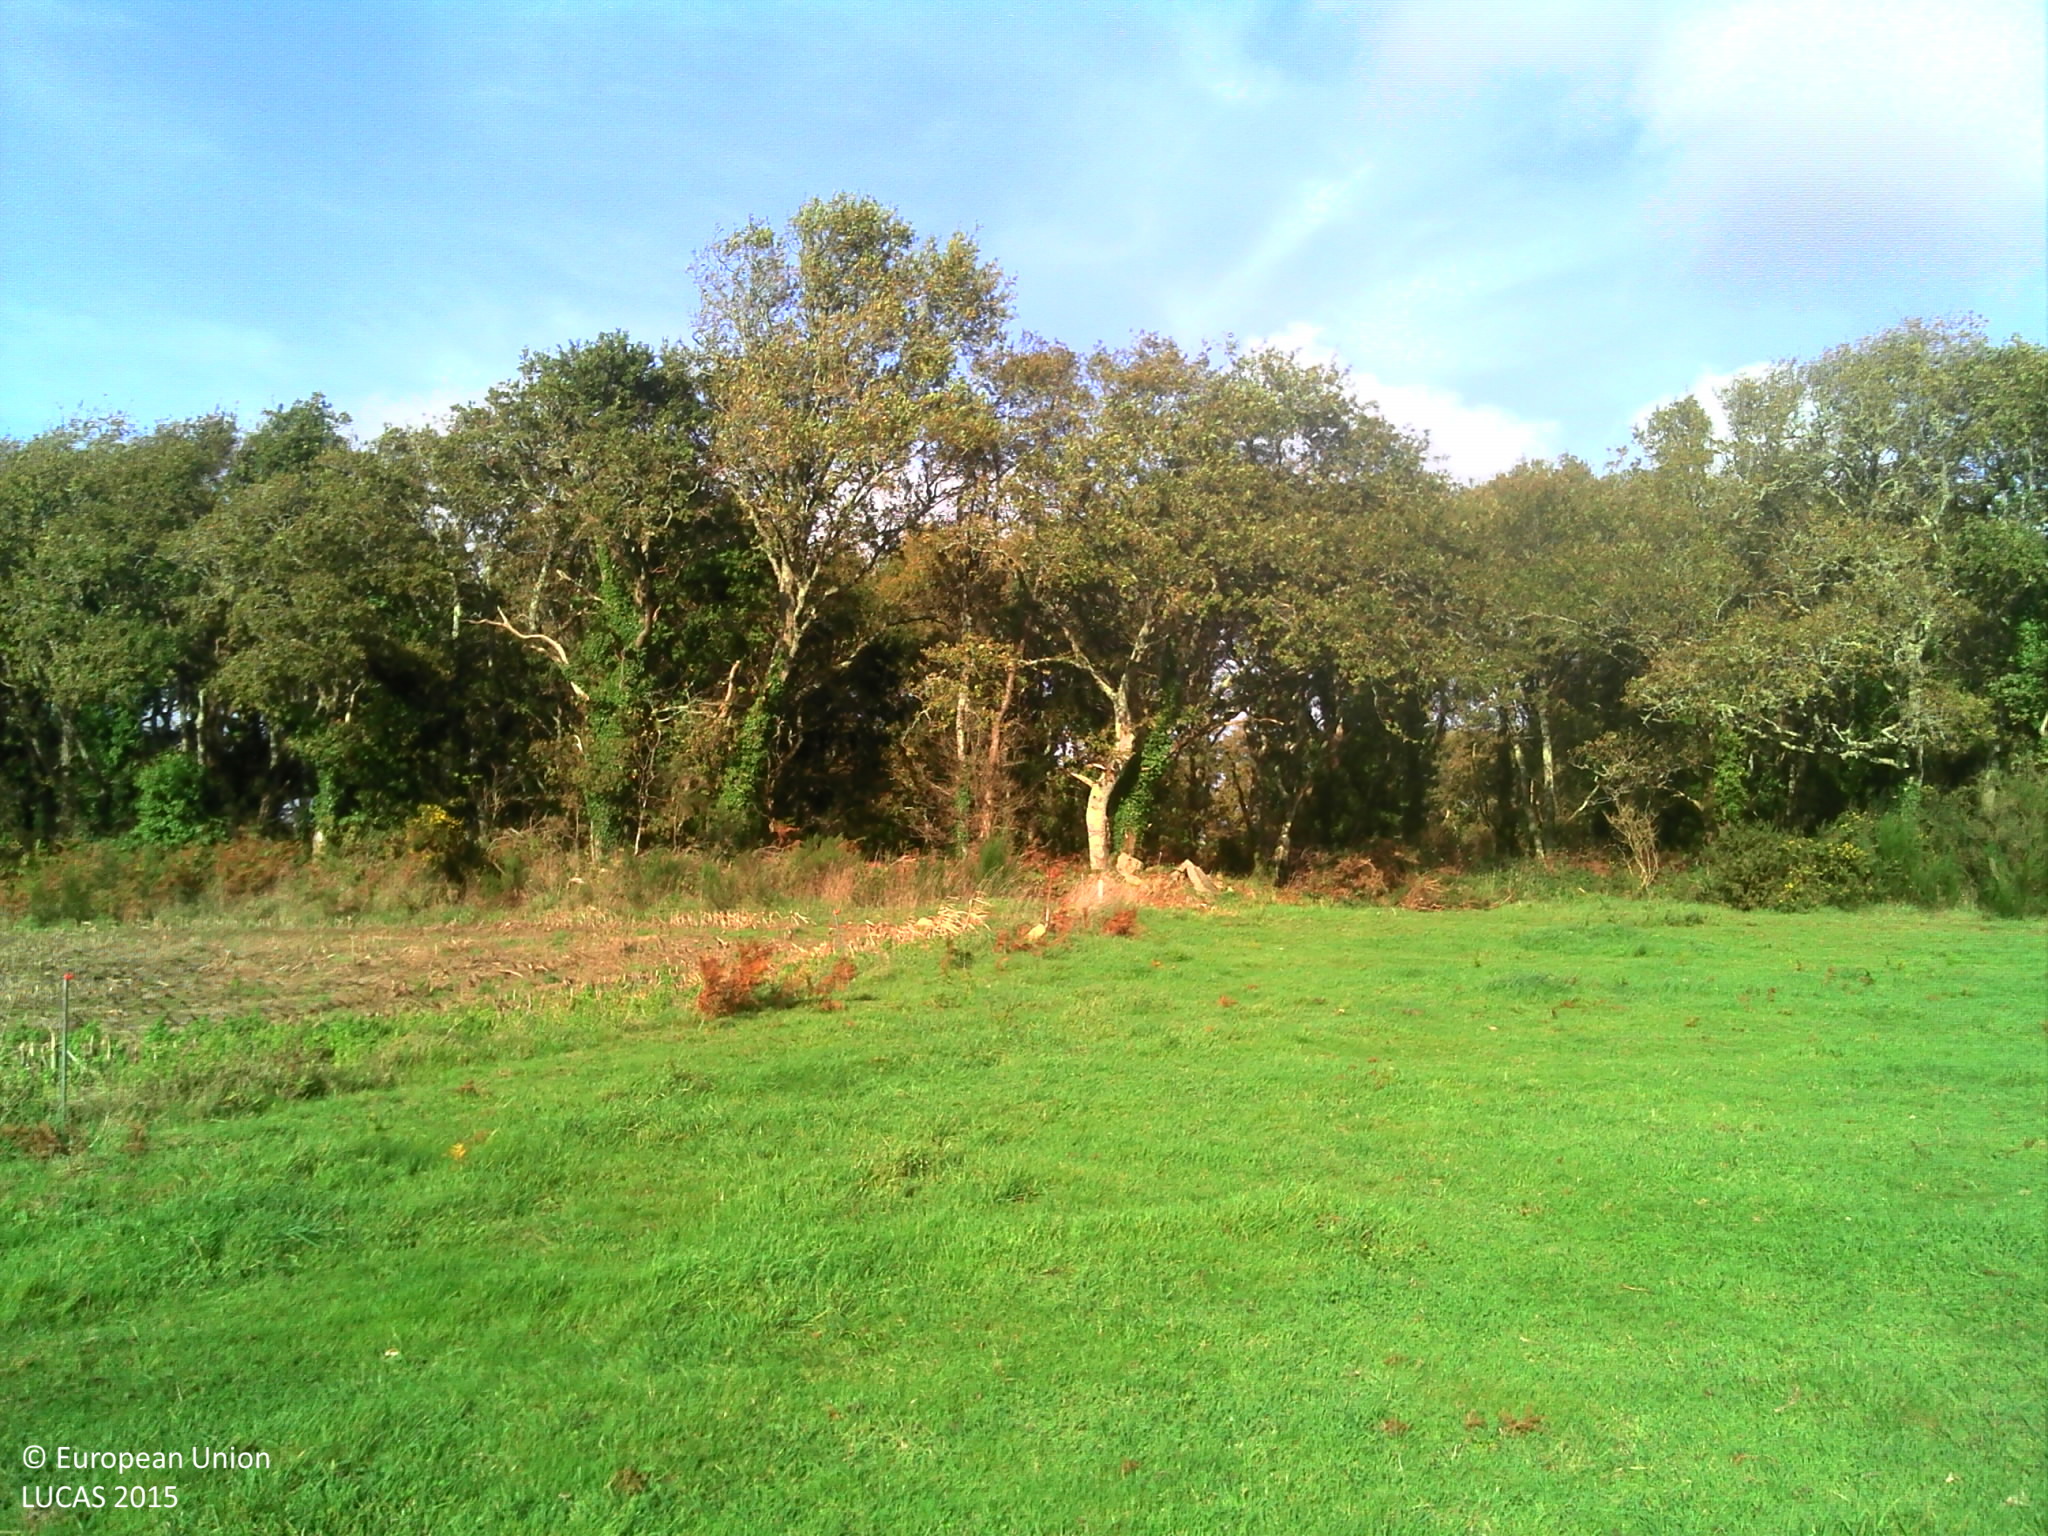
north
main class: Grassland
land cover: Grassland without tree/shrub cover
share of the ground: > 75 %
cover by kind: herbaceous plants 100 %
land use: Agriculture (excluding fallow land and kitchen gardens)
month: November
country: FR
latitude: 47.6240
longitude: -3.0673
